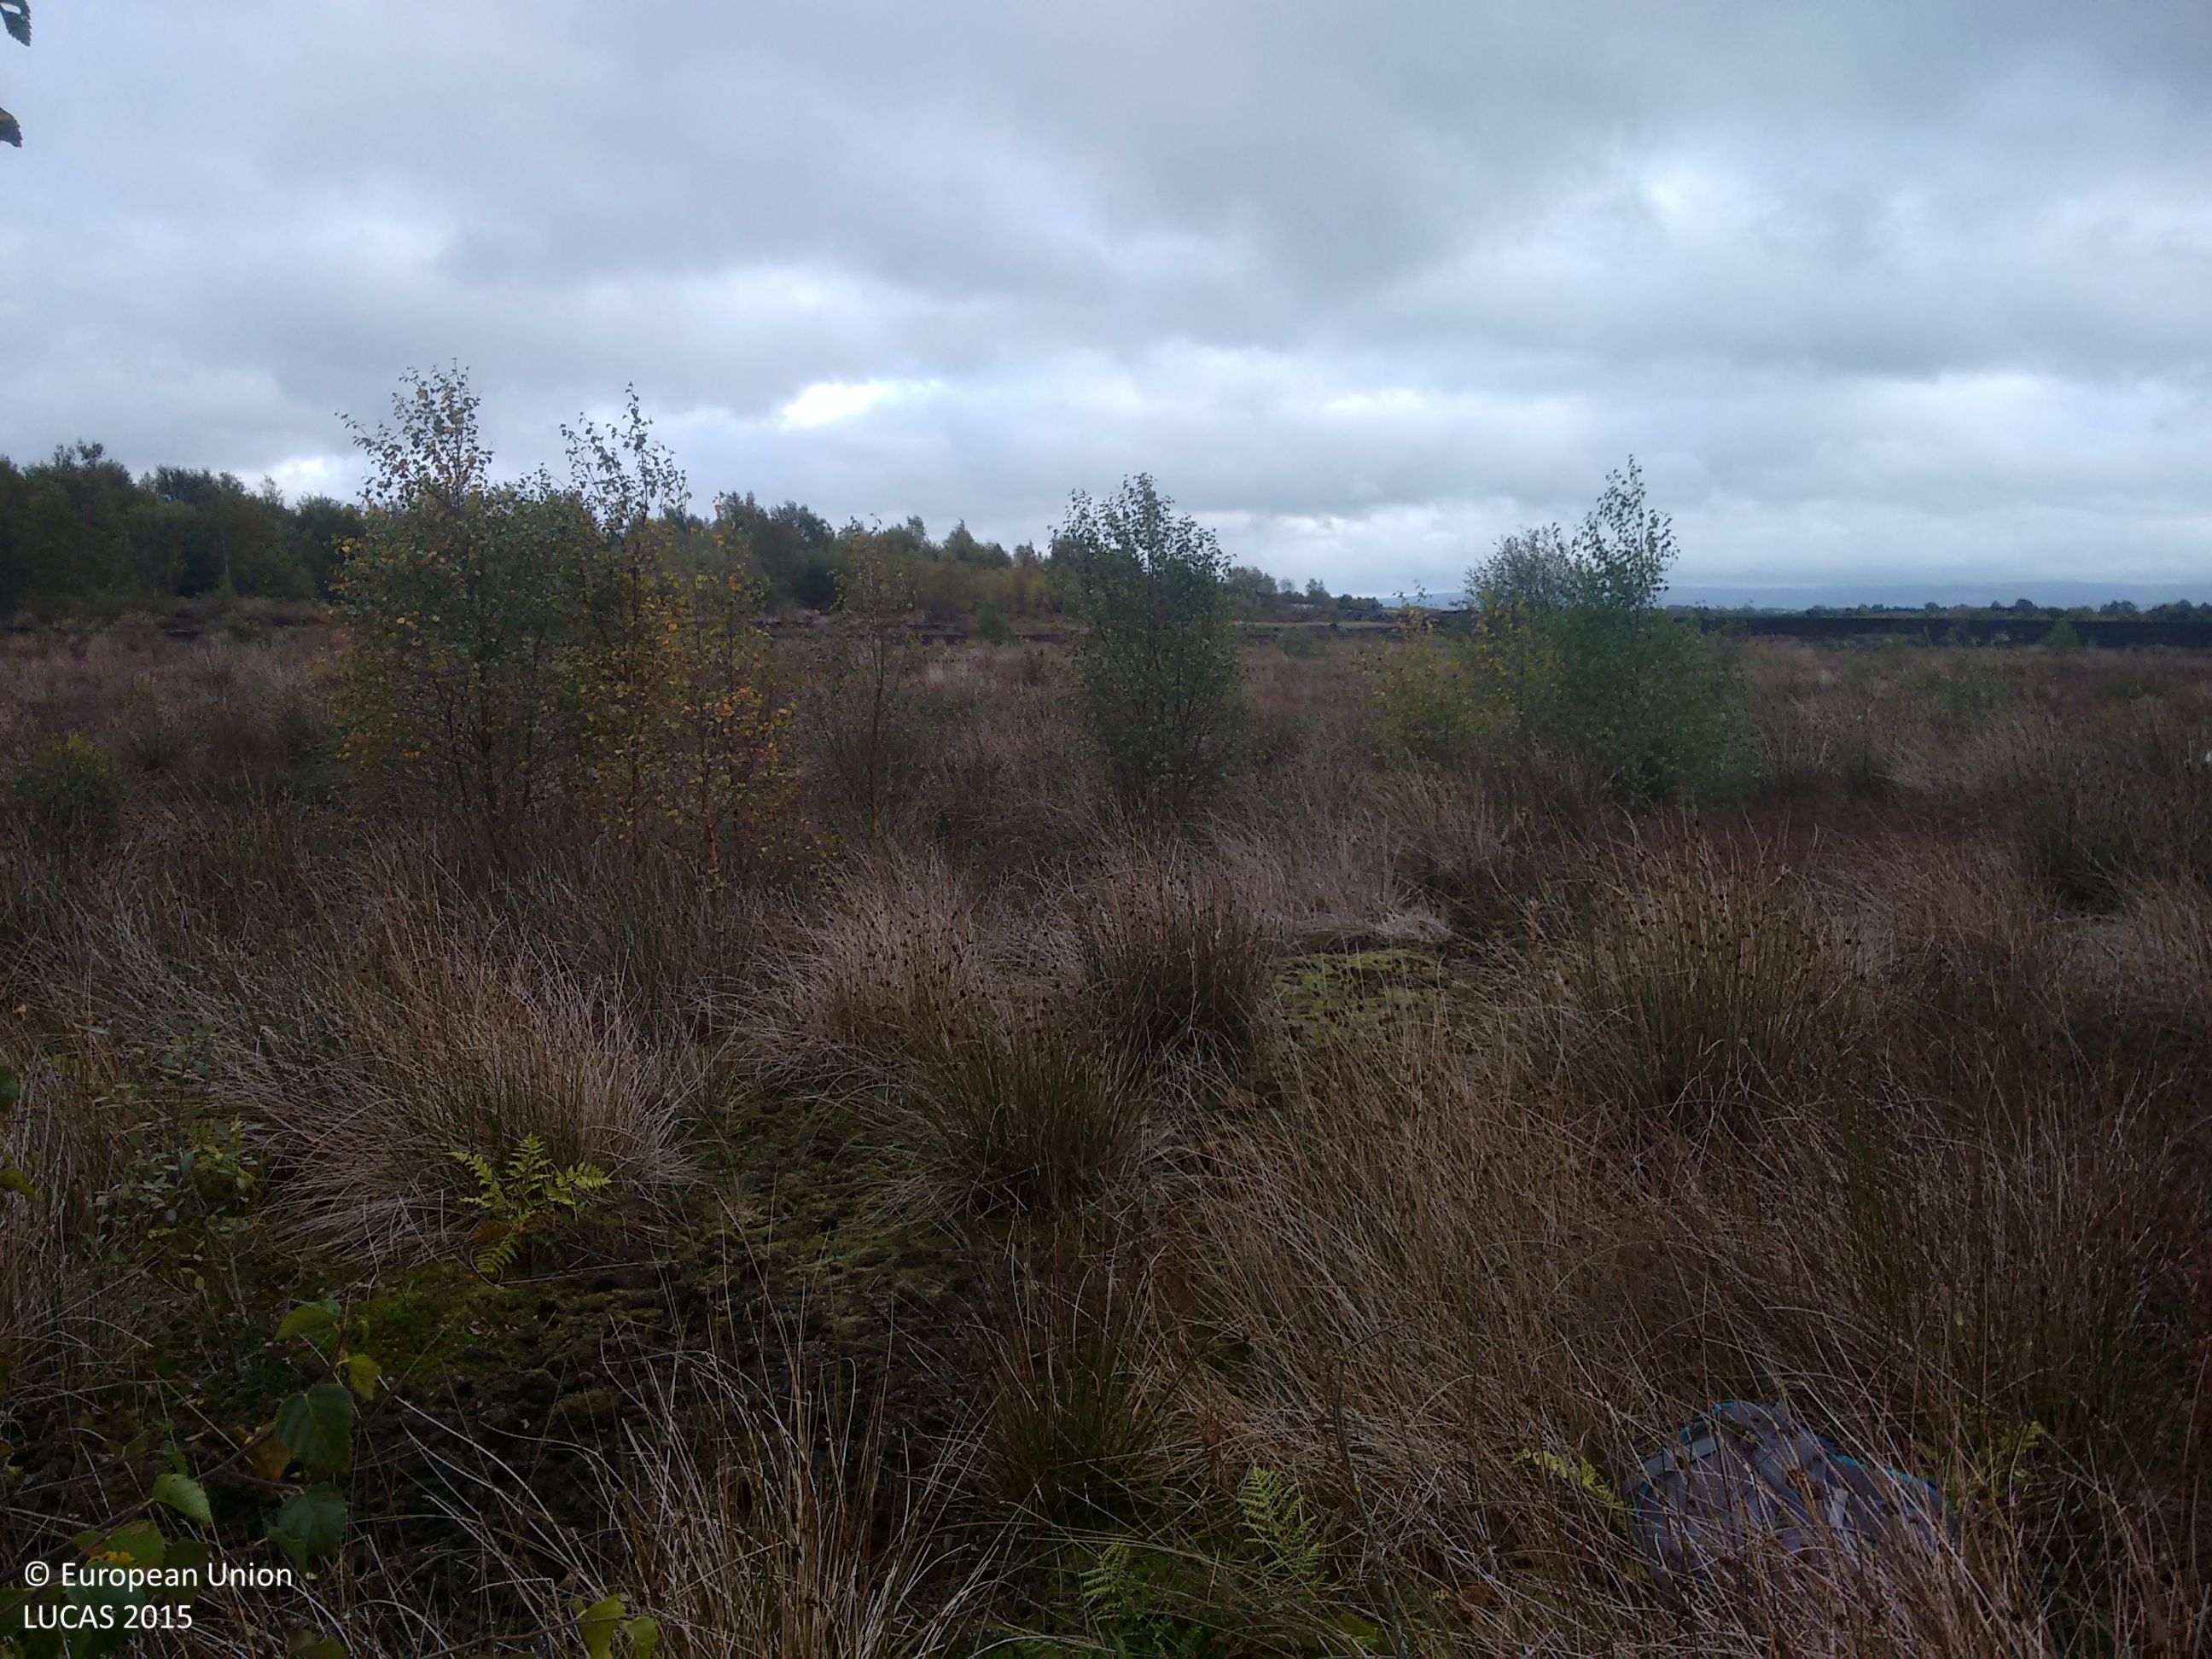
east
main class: Woodland
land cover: Broadleaved woodland
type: acidophilous oak and oak-birch forest
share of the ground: > 75 %
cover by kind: broadleaved forest trees 75 %, herbaceous plants 20 %, lichens and mosses 5 %
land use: Semi-natural and natural areas not in use
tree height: > 5 m
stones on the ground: < 10 %
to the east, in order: Broadleaved woodland; Peatbogs; Other bare soil; Spontaneously vegetated surfaces; Broadleaved woodland; Other bare soil; Broadleaved woodland
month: October
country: IE
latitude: 53.1856
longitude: -7.8436
